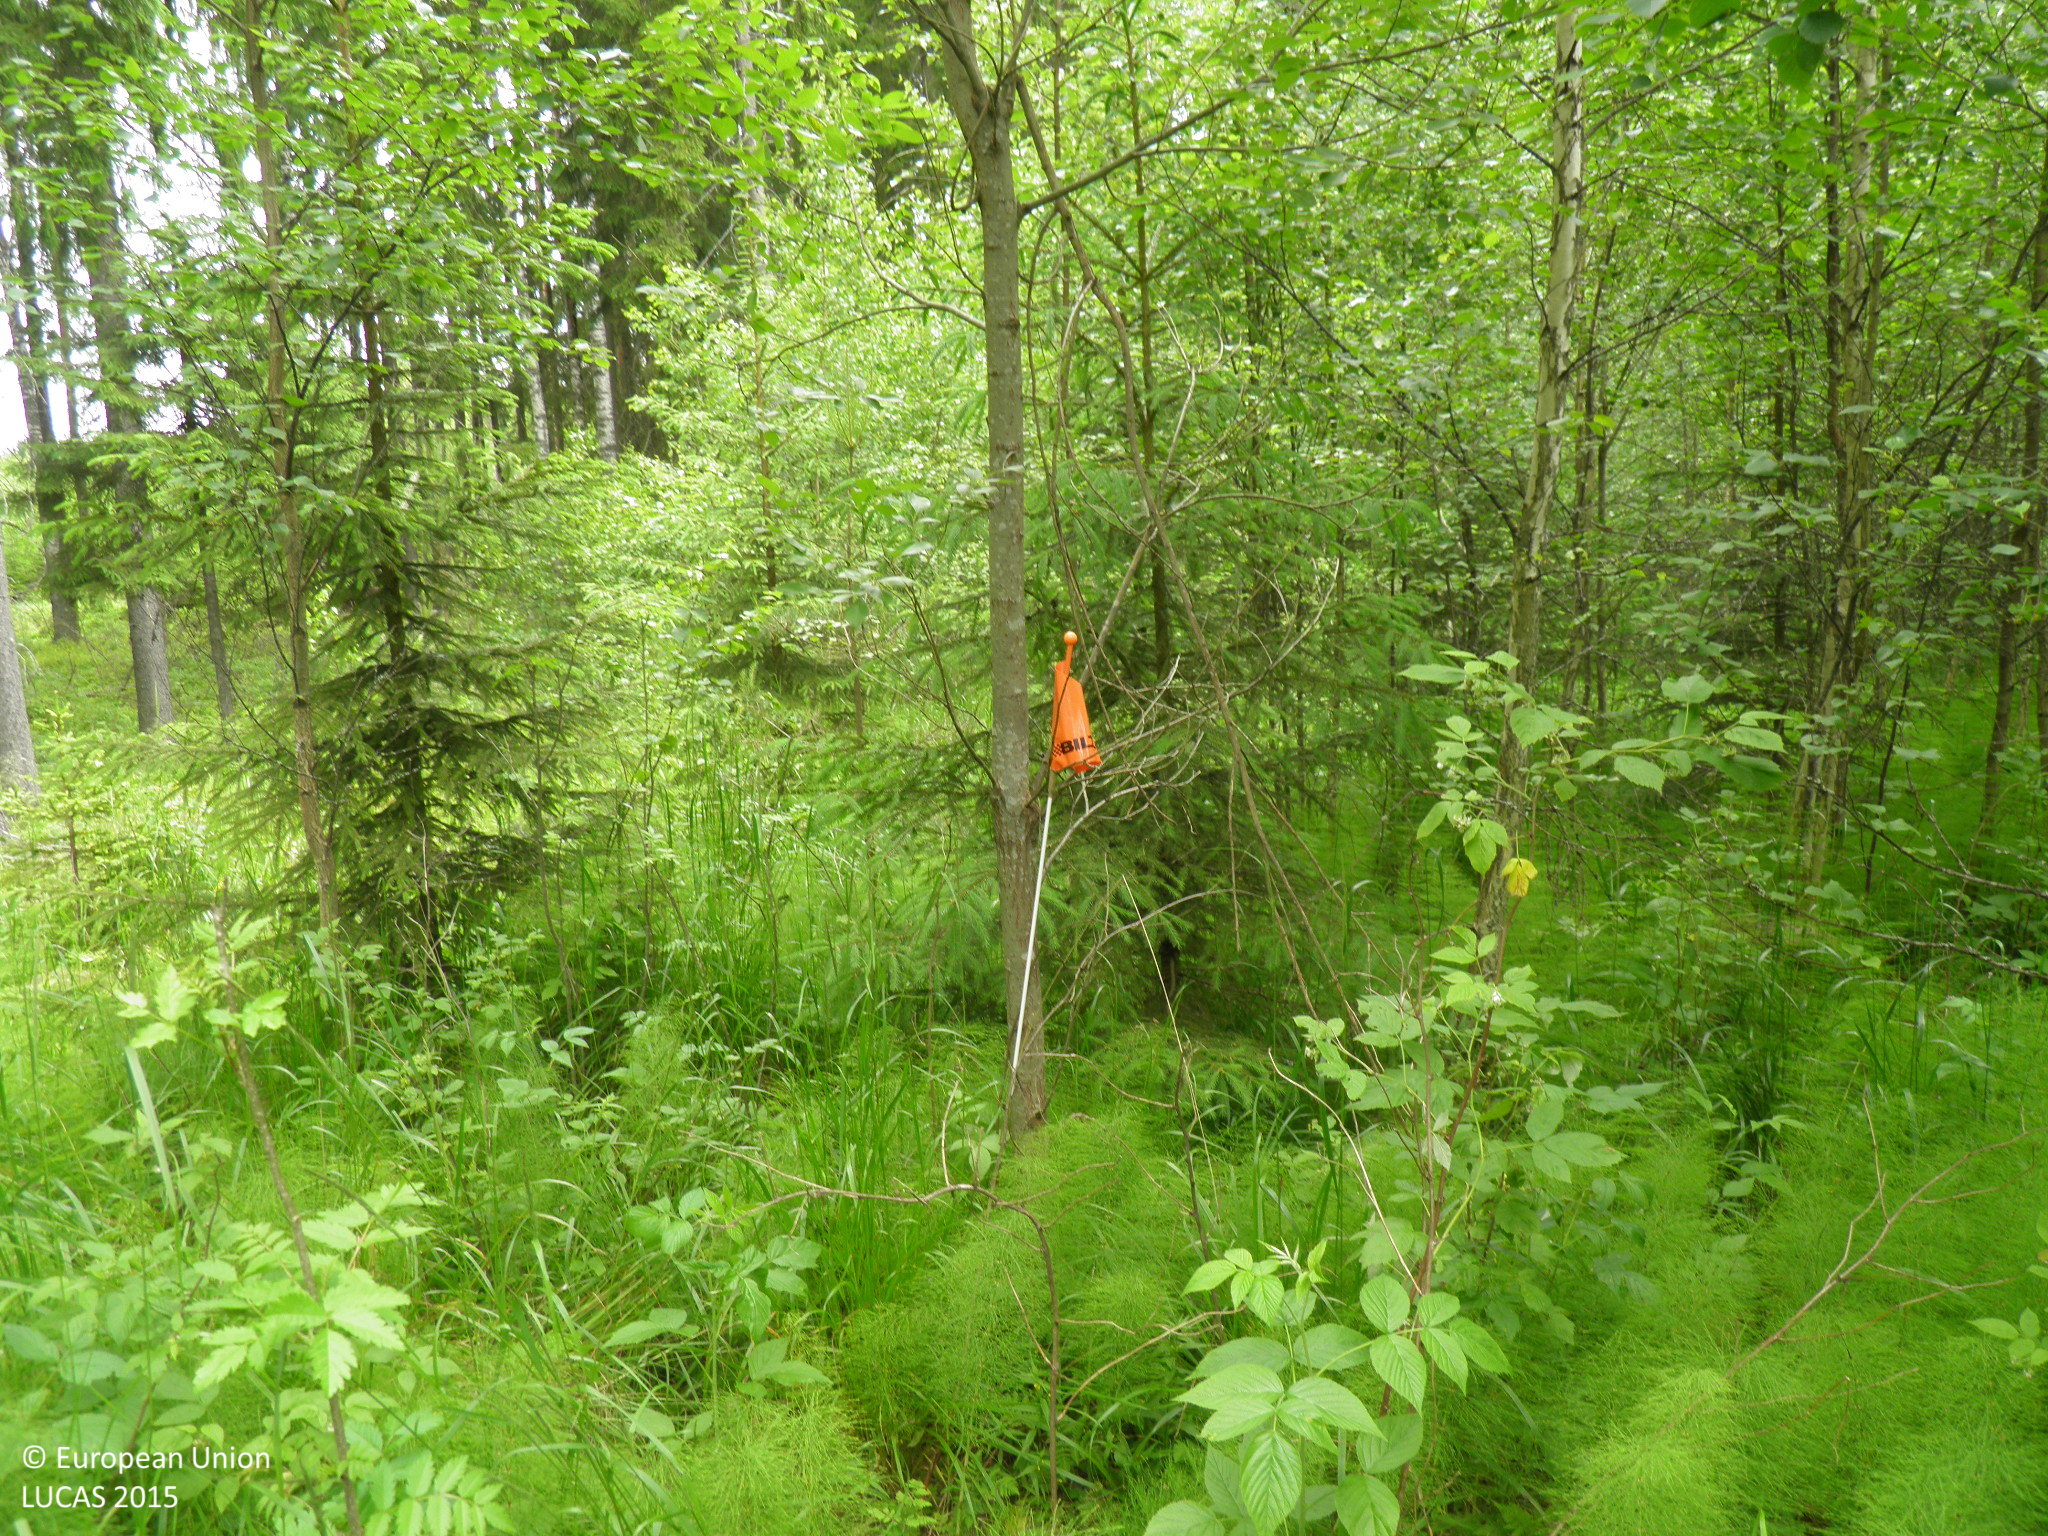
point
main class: Woodland
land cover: Broadleaved woodland
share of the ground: > 75 %
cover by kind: broadleaved forest trees 75 %, shrubs 10 %, herbaceous plants 10 %, coniferous forest trees 5 %
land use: Forestry
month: July
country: FI
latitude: 60.6862
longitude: 22.6506
